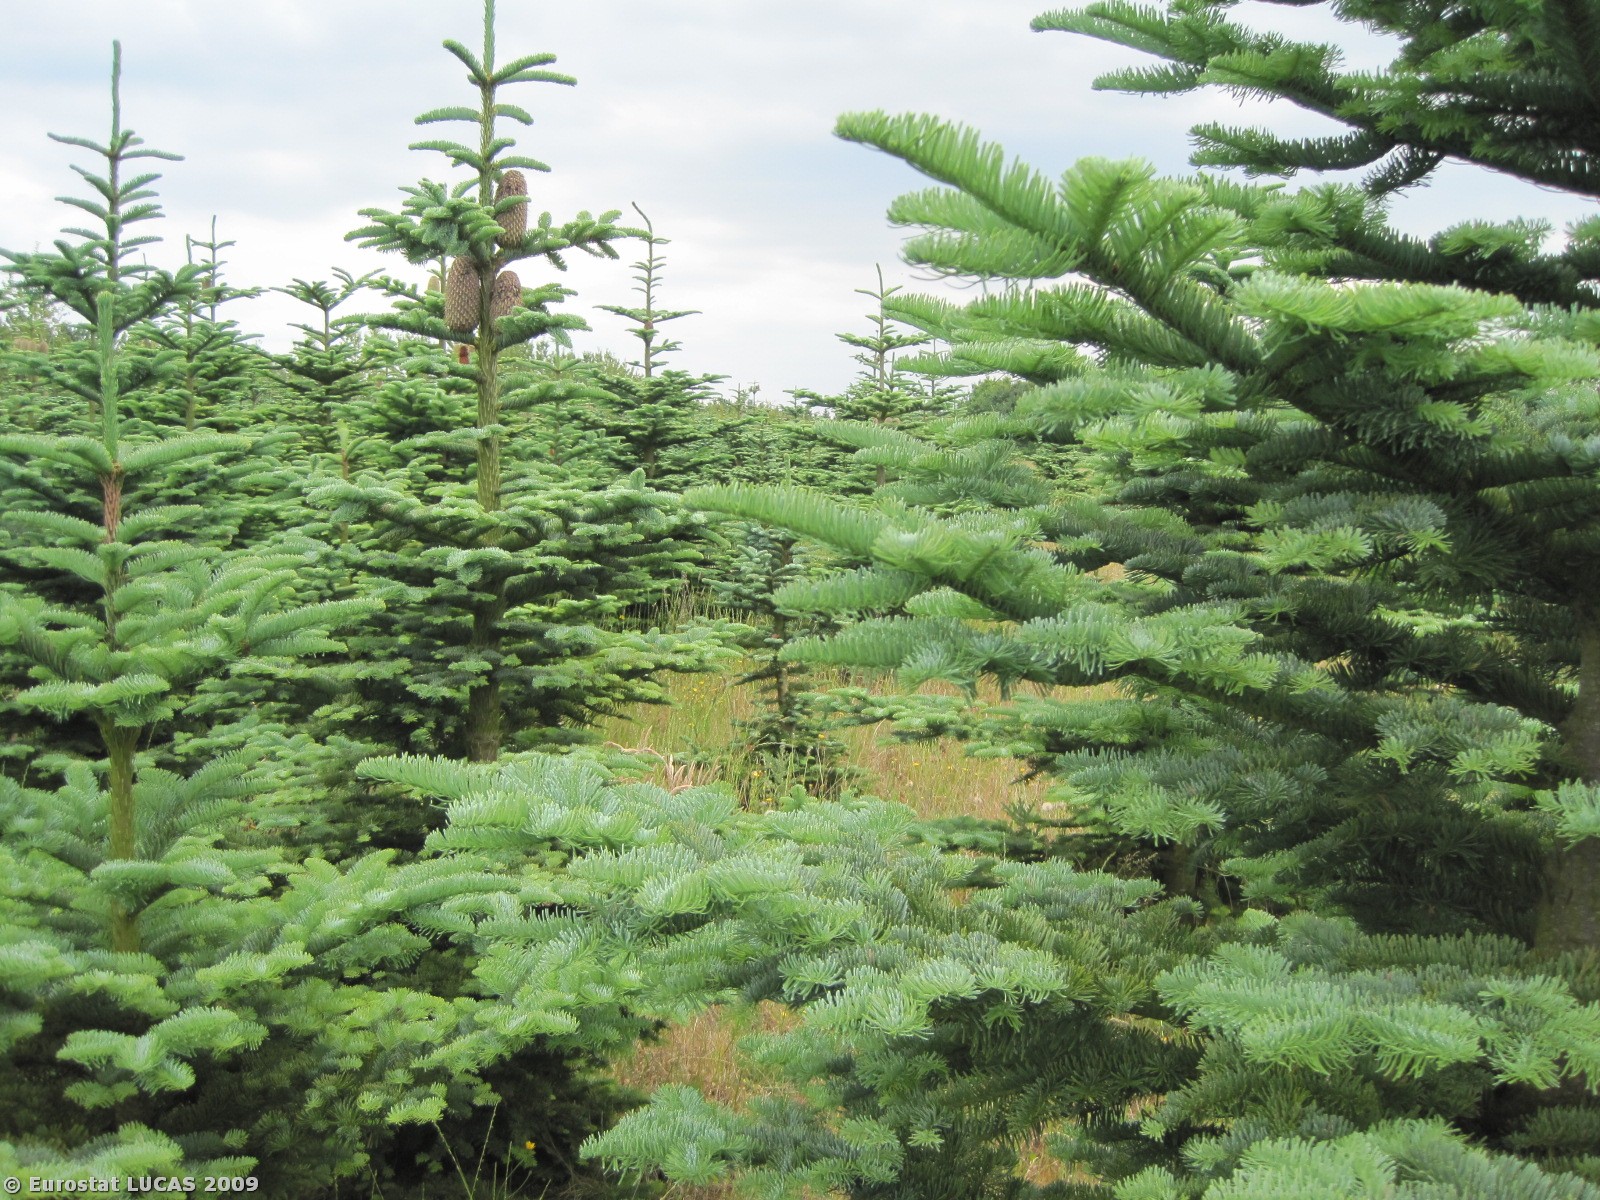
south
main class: Woodland
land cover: Coniferous woodland
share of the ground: 50 - 75 %
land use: Forestry
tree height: > 5 m
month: June
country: DK
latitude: 56.3216
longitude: 8.4011
